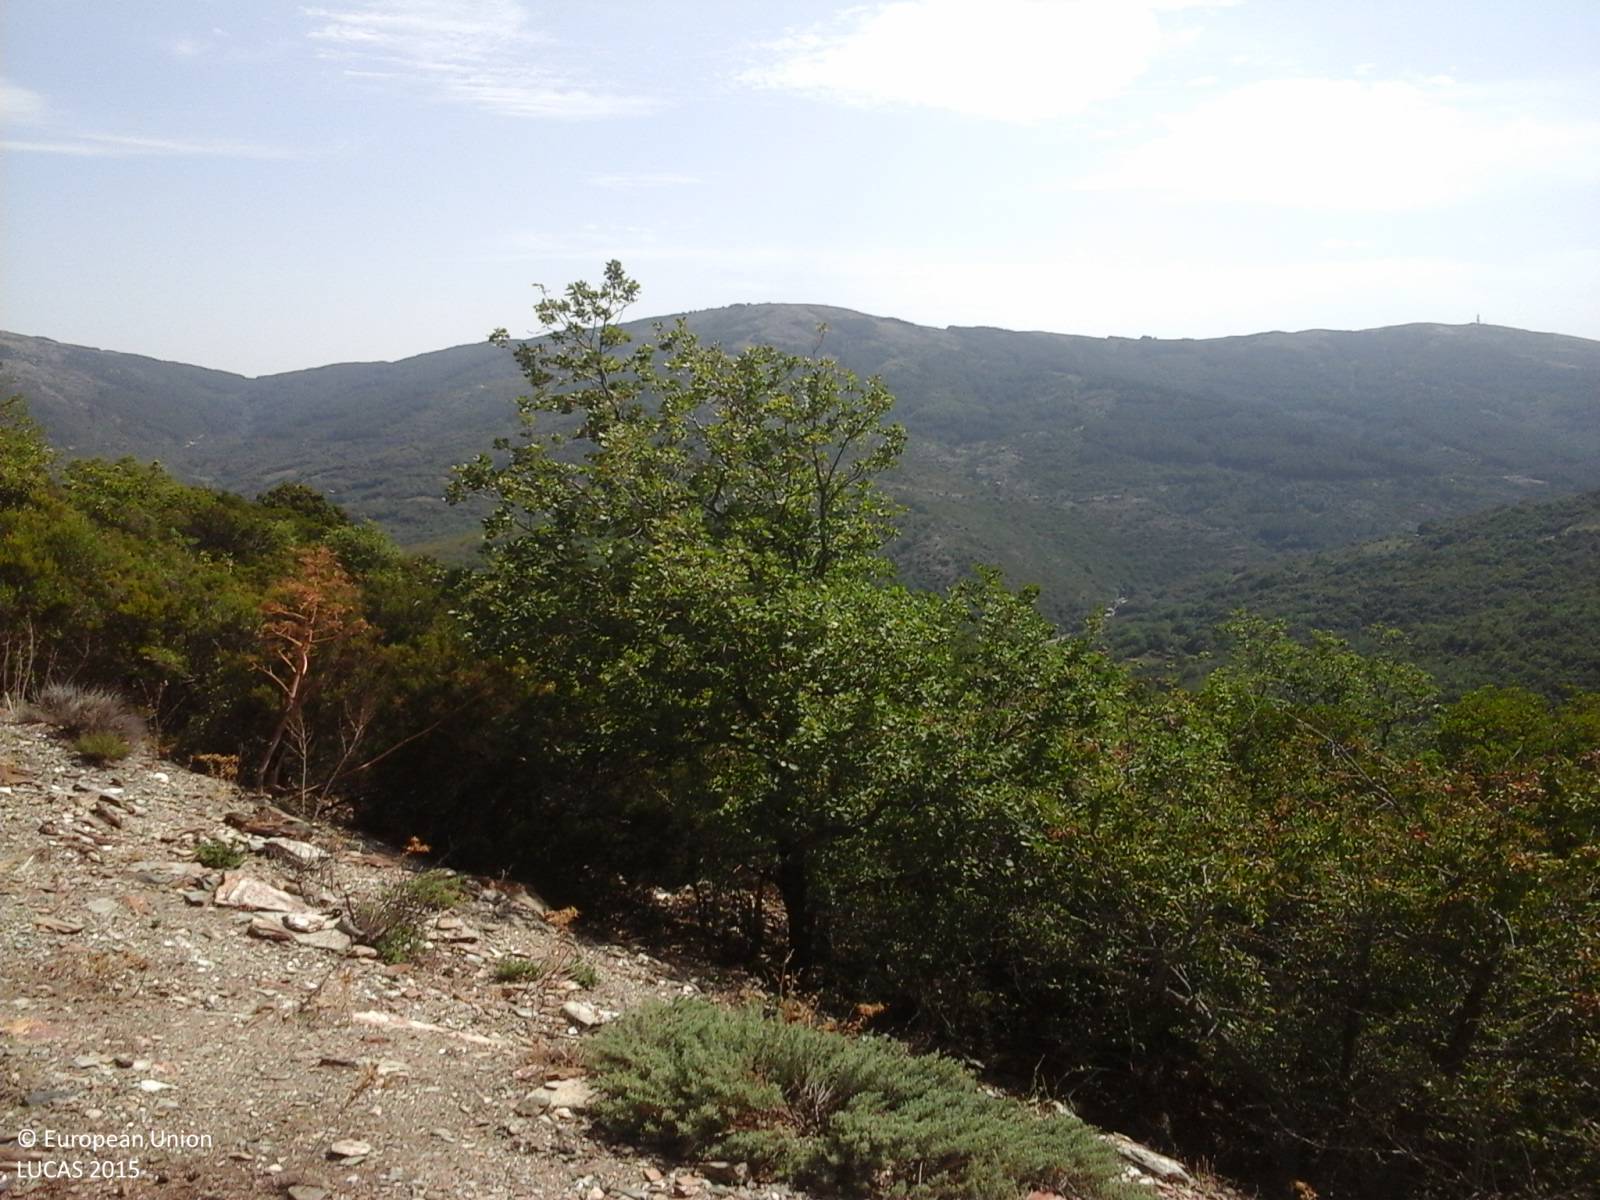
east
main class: Woodland
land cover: Broadleaved woodland
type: broadleaved evergreen forest
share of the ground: > 75 %
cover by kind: broadleaved forest trees 80 %, shrubs 15 %, herbaceous plants 5 %
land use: Semi-natural and natural areas not in use
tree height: > 5 m
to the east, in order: Broadleaved woodland
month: September
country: IT
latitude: 39.8304
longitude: 9.3145
